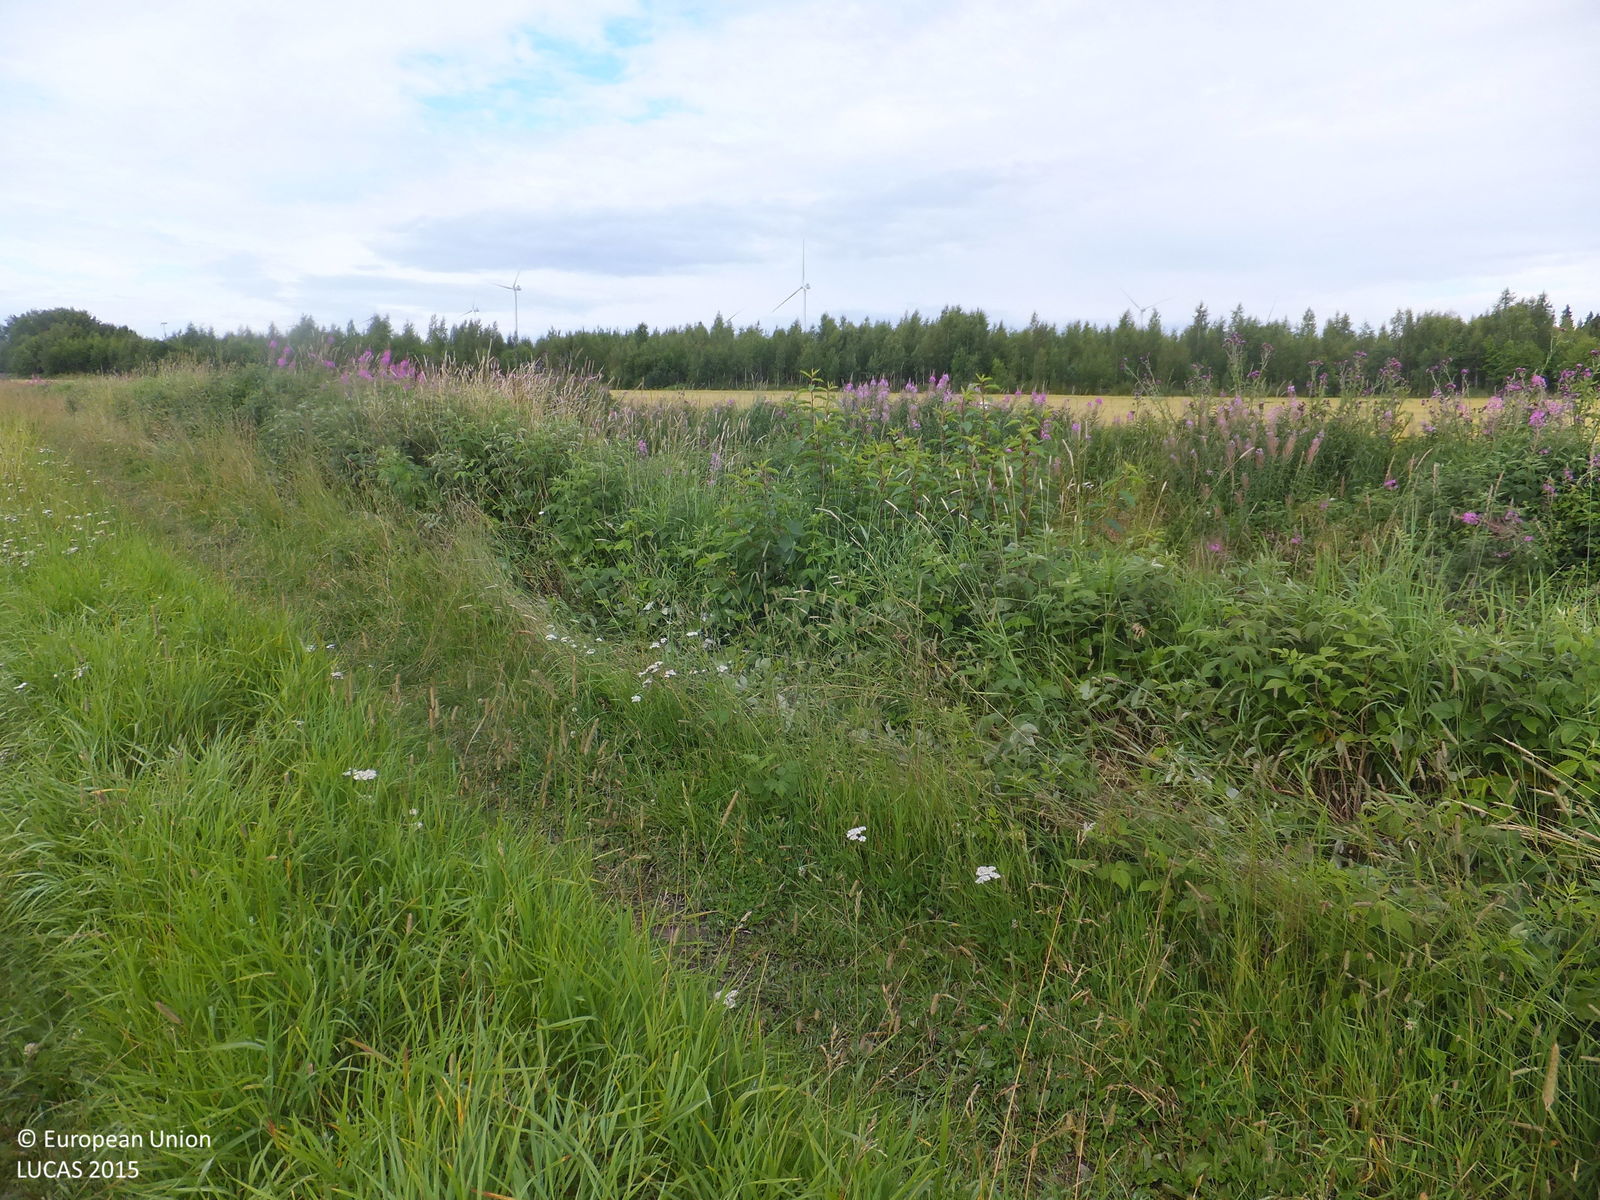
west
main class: Cropland
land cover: Barley
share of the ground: > 75 %
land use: Agriculture (excluding fallow land and kitchen gardens)
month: July
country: FI
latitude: 63.0409
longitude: 22.0466
